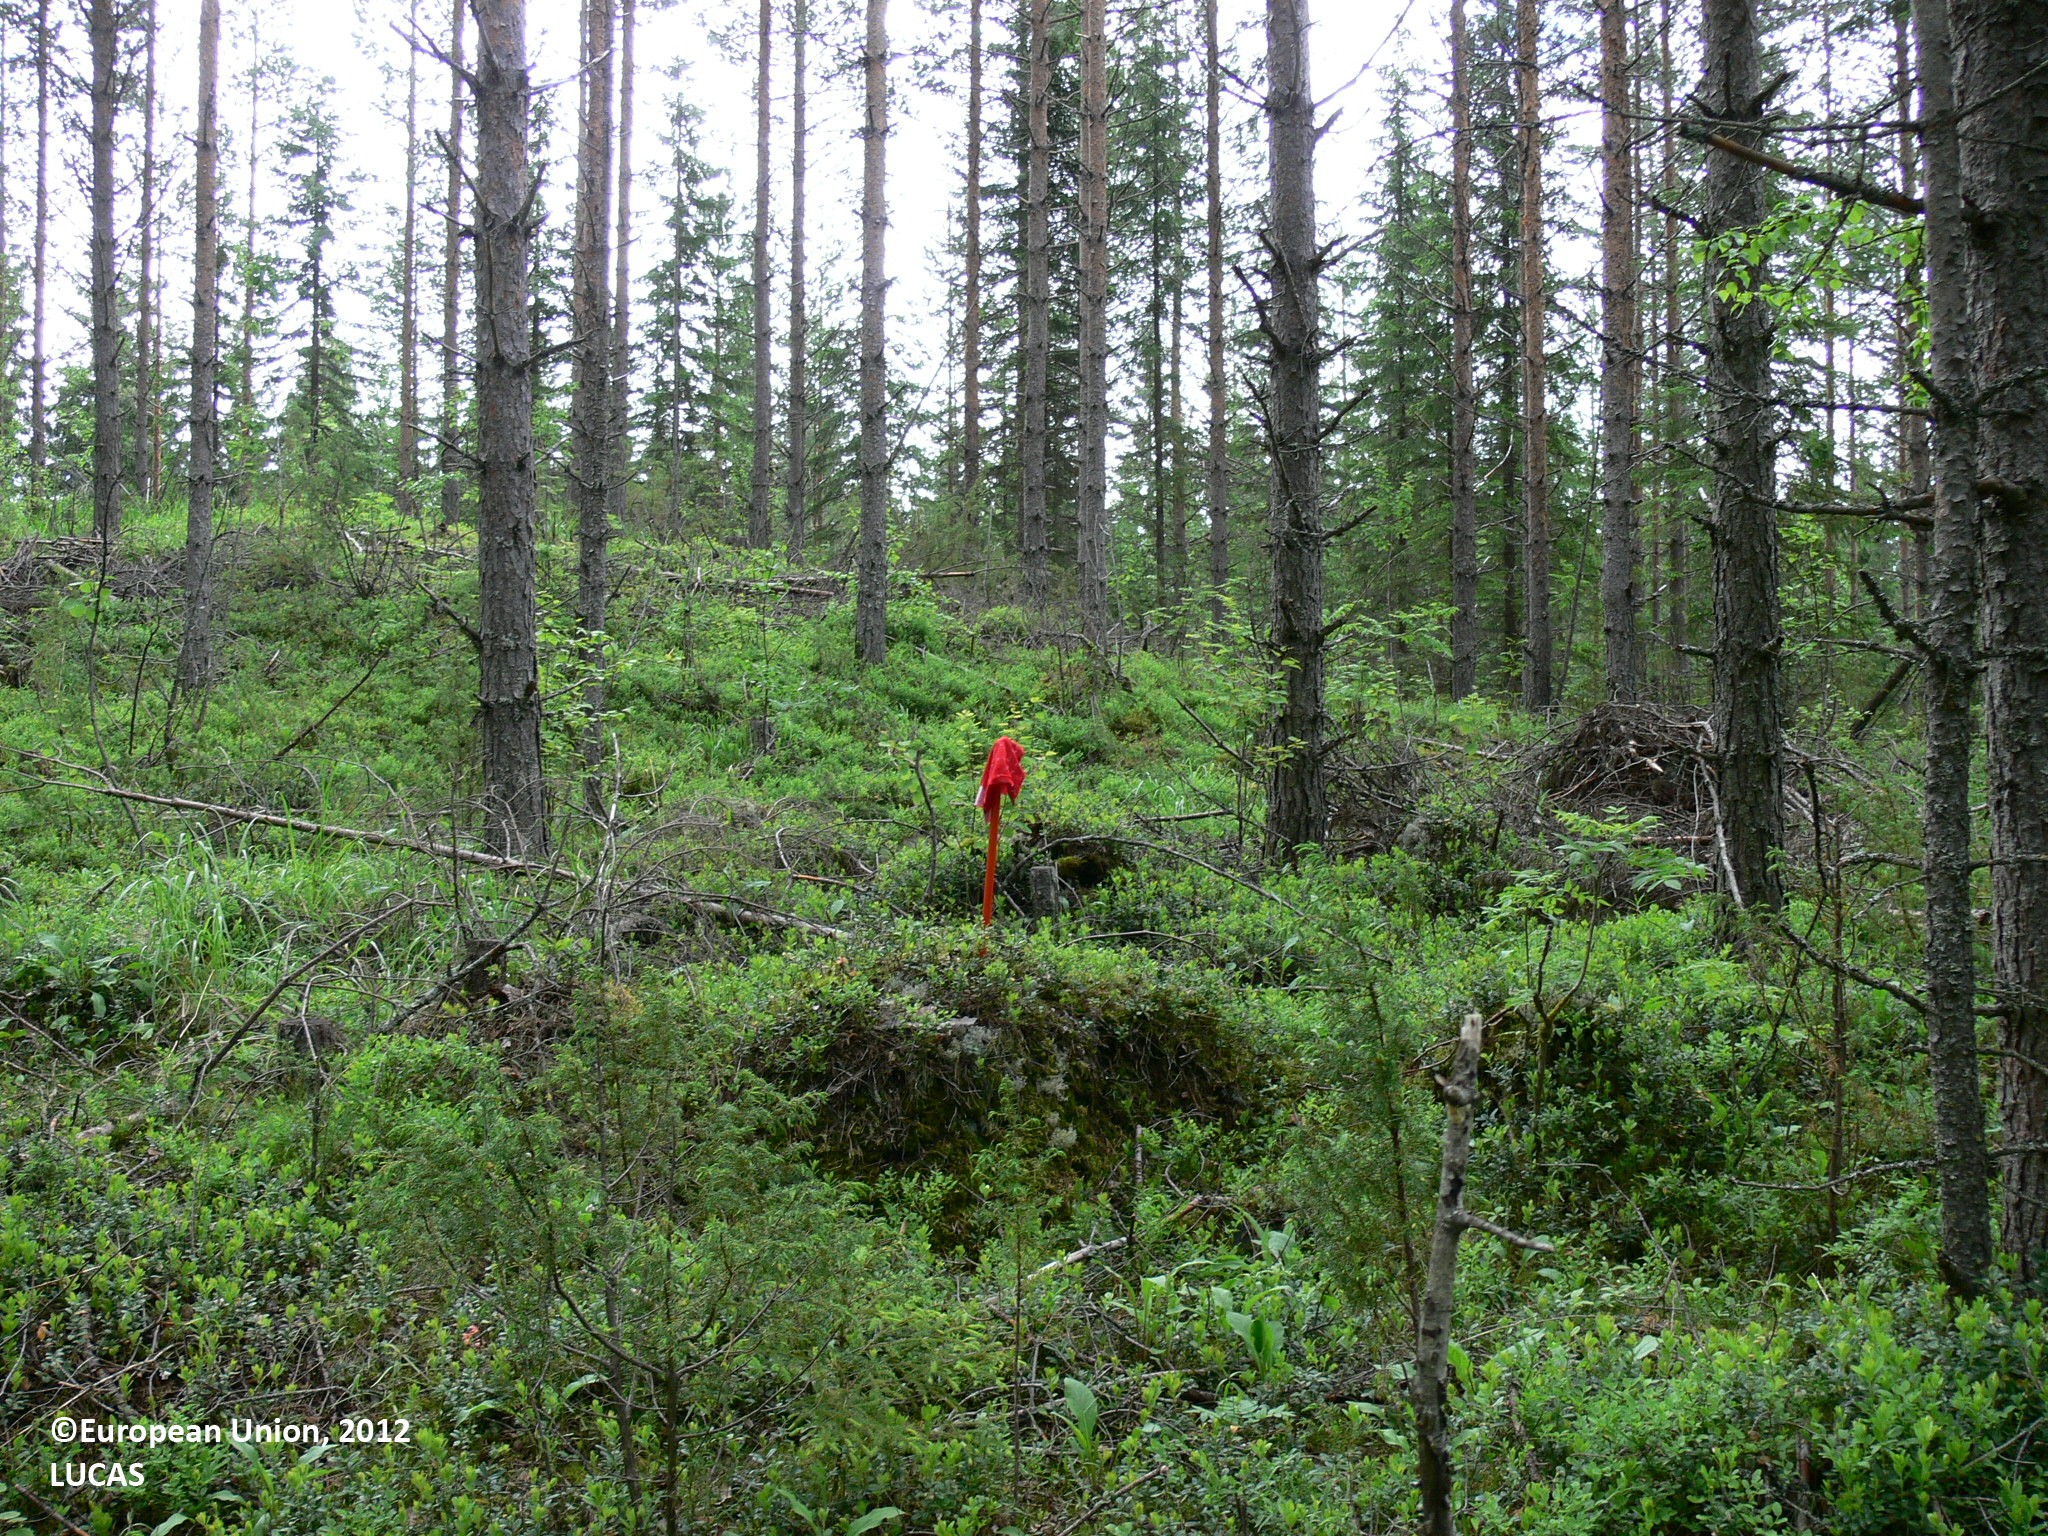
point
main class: Woodland
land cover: Pine dominated coniferous woodland
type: boreal forest
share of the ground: 50 - 75 %
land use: Forestry
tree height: > 5 m
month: June
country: FI
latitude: 62.7101
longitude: 30.3922
